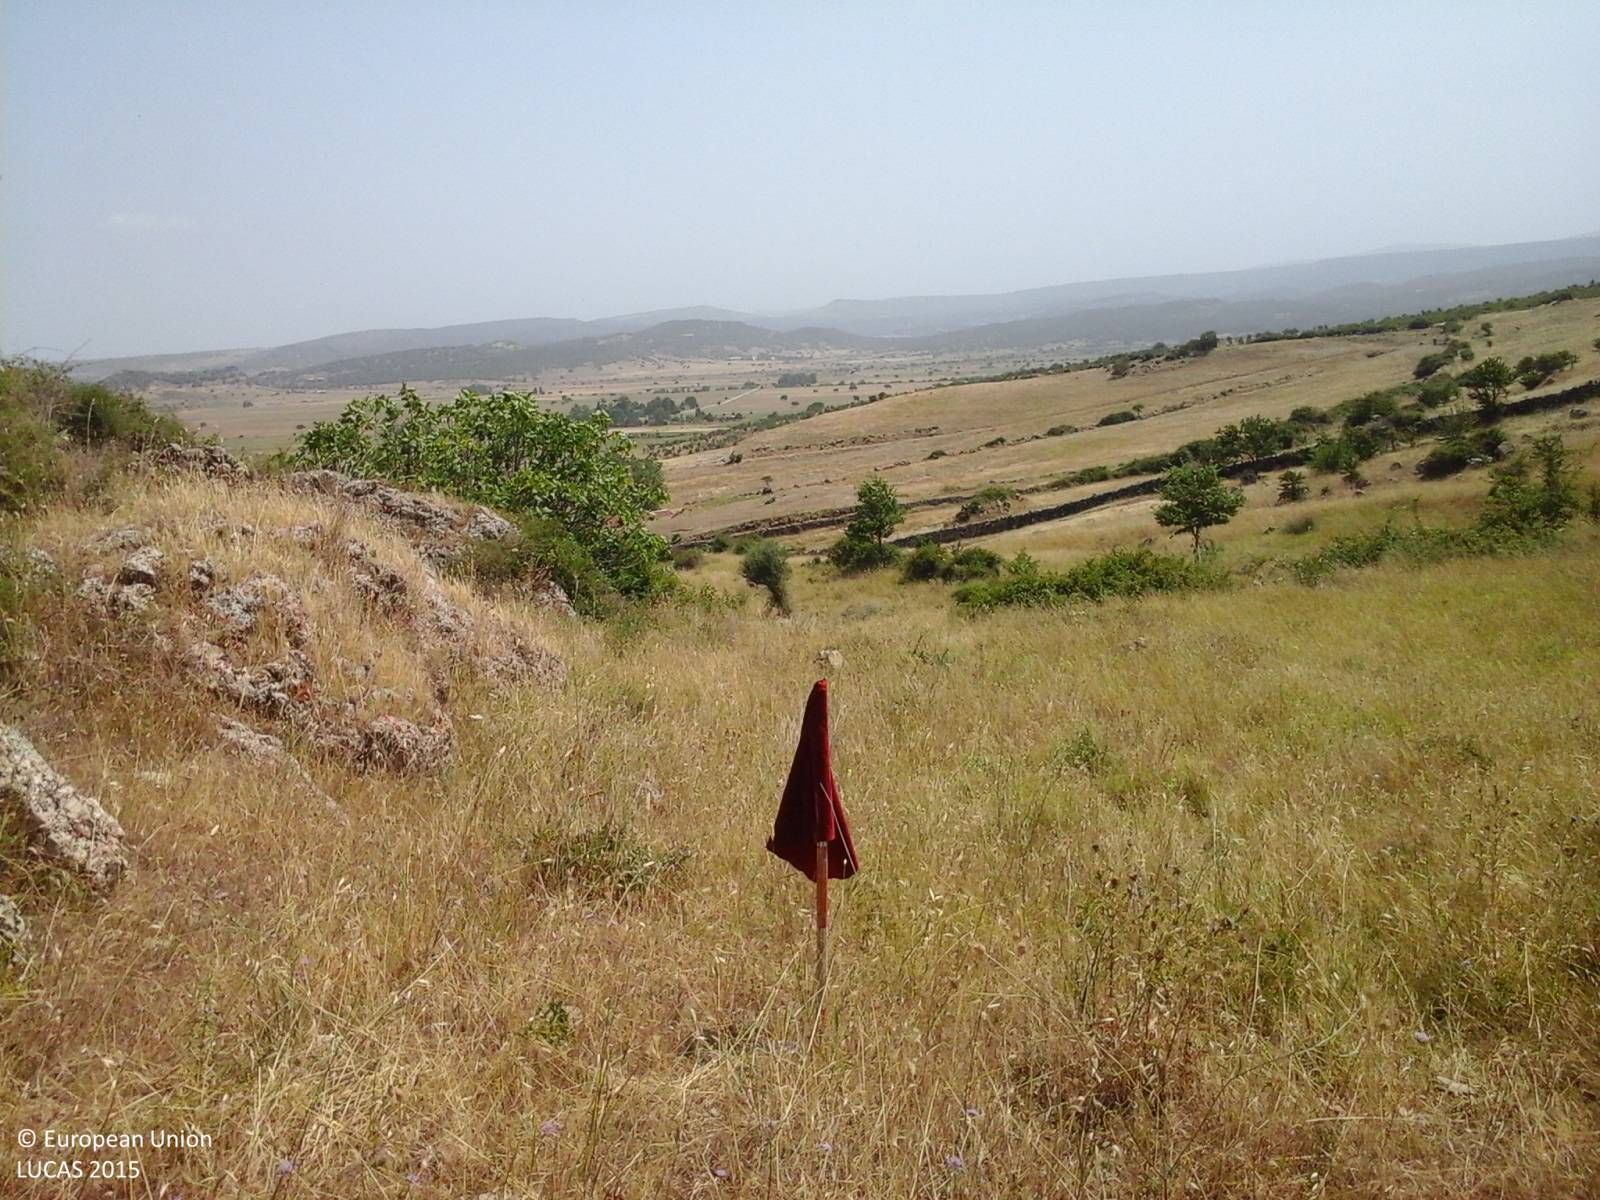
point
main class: Grassland
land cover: Grassland without tree/shrub cover
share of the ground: 25 - 50 %
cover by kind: herbaceous plants 100 %
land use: Agriculture (excluding fallow land and kitchen gardens)
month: July
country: IT
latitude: 40.4231
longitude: 8.8156
